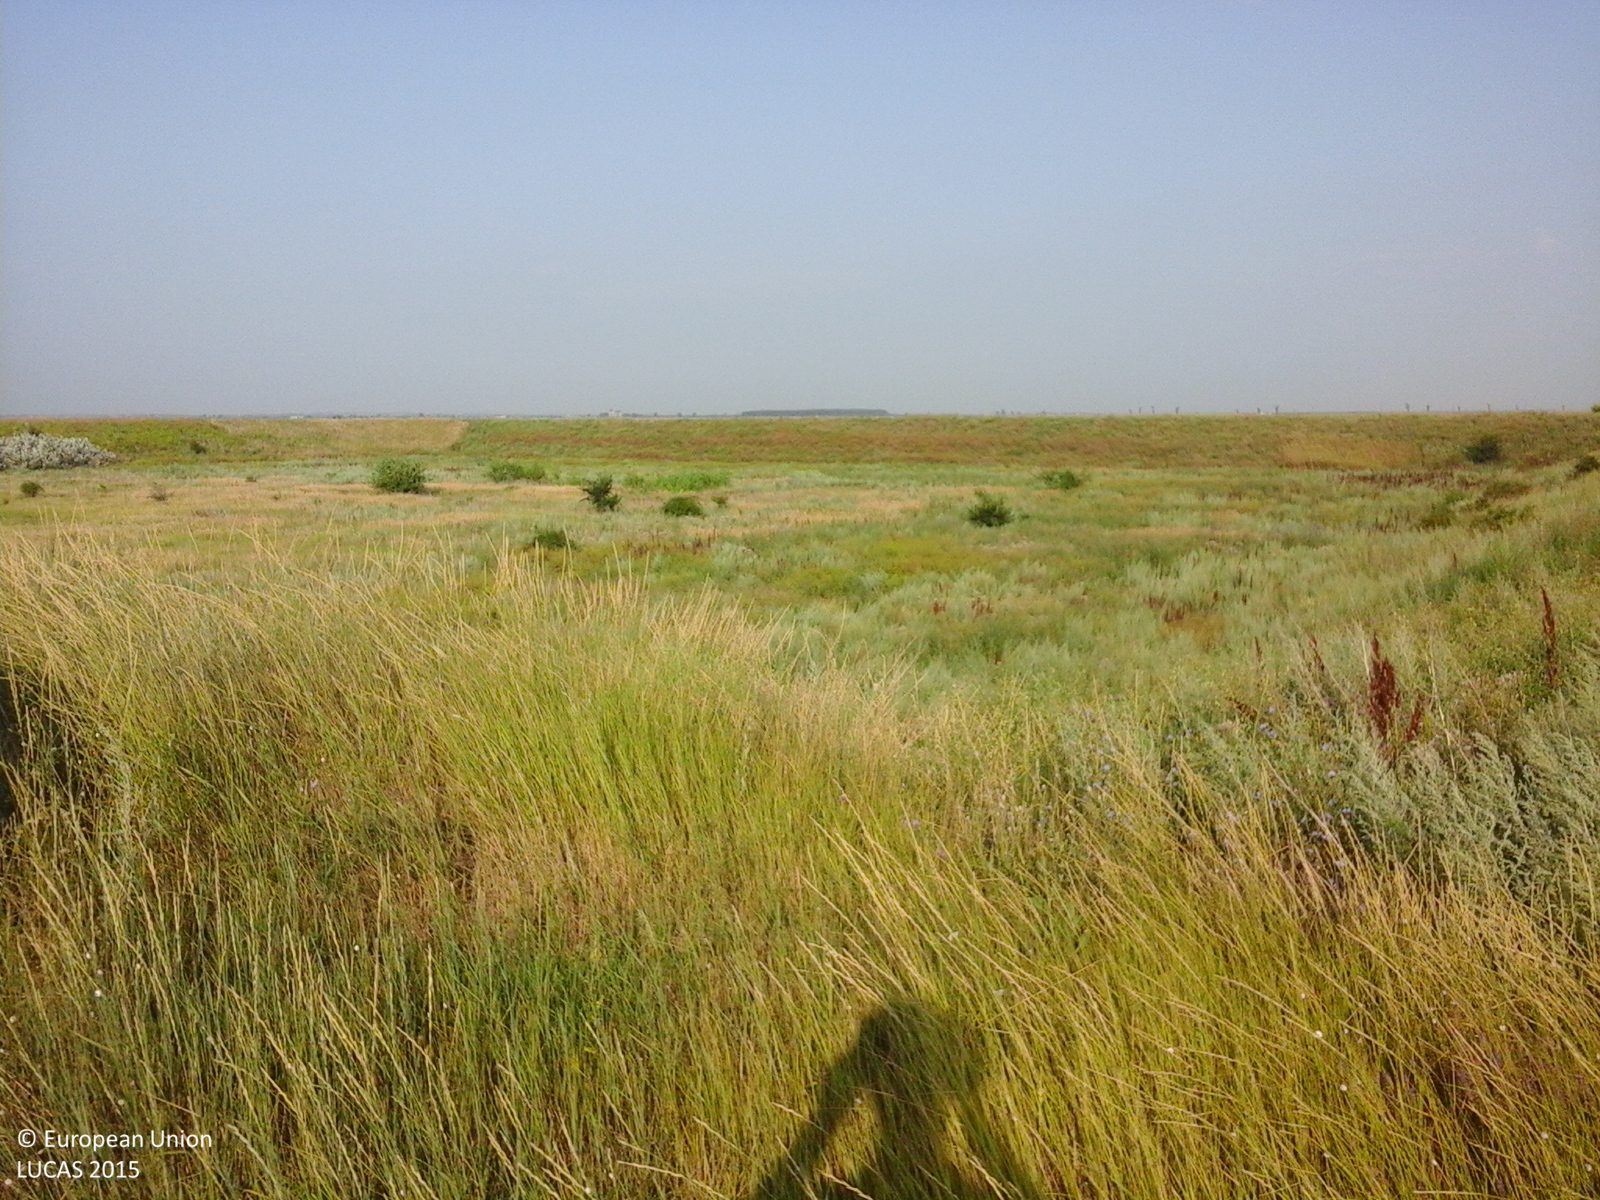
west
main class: Grassland
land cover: Spontaneously vegetated surfaces
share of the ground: > 75 %
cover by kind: herbaceous plants 100 %
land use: Fallow land
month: July
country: RO
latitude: 44.6536
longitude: 27.0678
